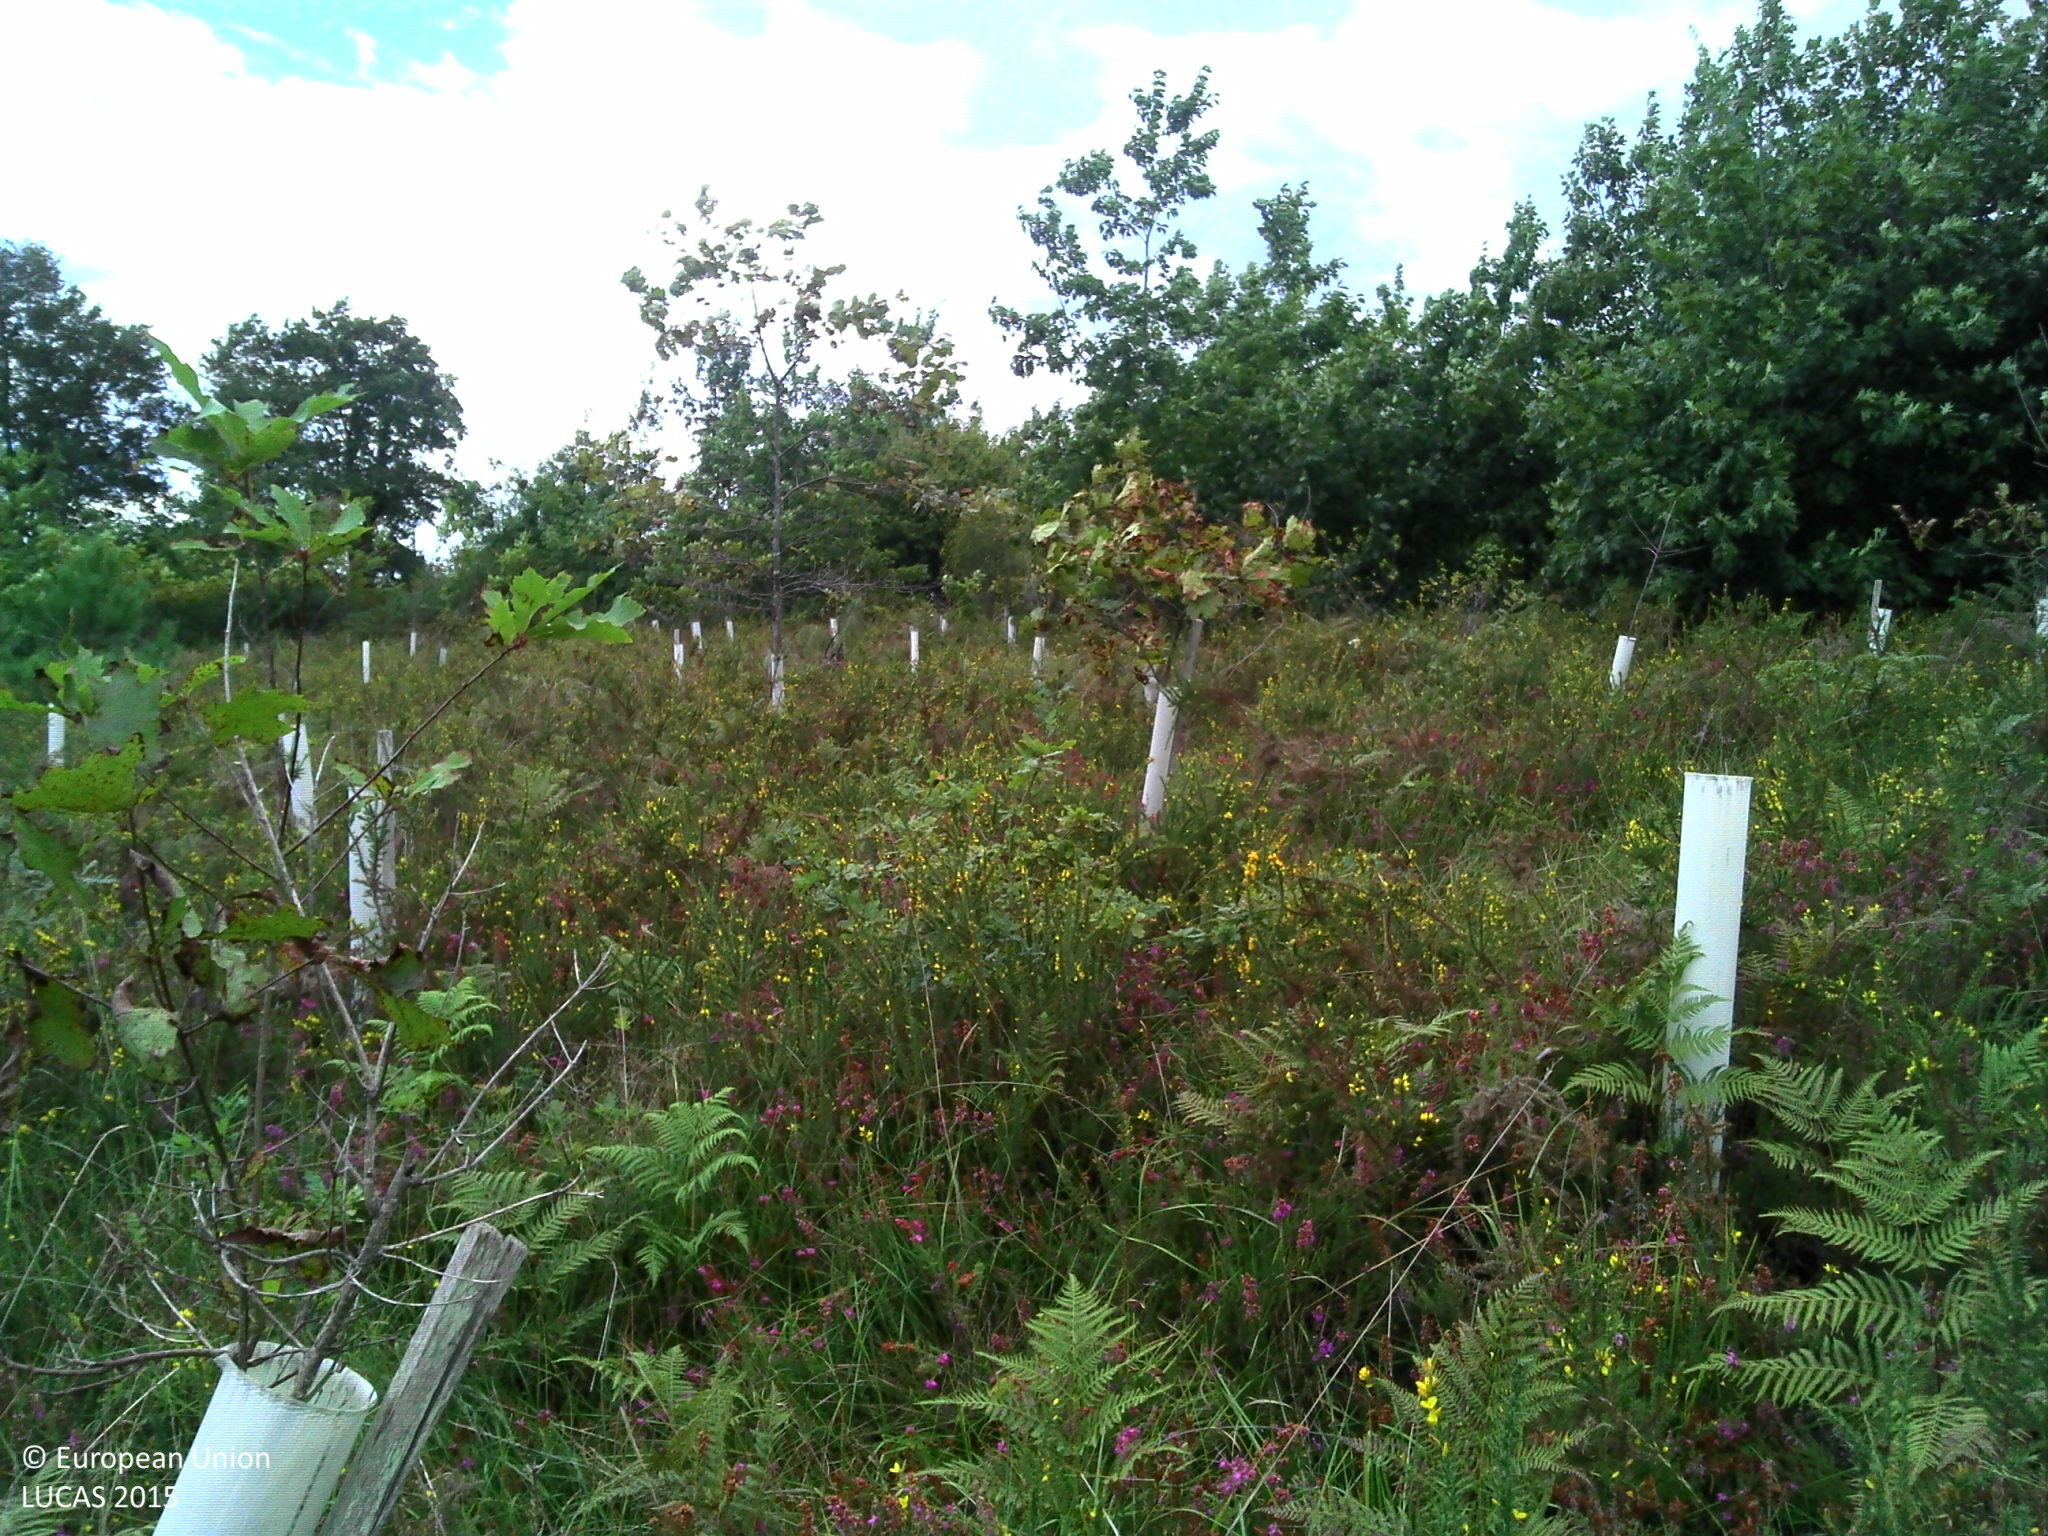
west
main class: Woodland
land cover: Broadleaved woodland
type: exotic forest
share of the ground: 10 - 25 %
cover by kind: shrubs 40 %, herbaceous plants 40 %, broadleaved forest trees 20 %
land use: Forestry
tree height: > 5 m
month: September
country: FR
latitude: 43.3585
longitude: -0.7076
